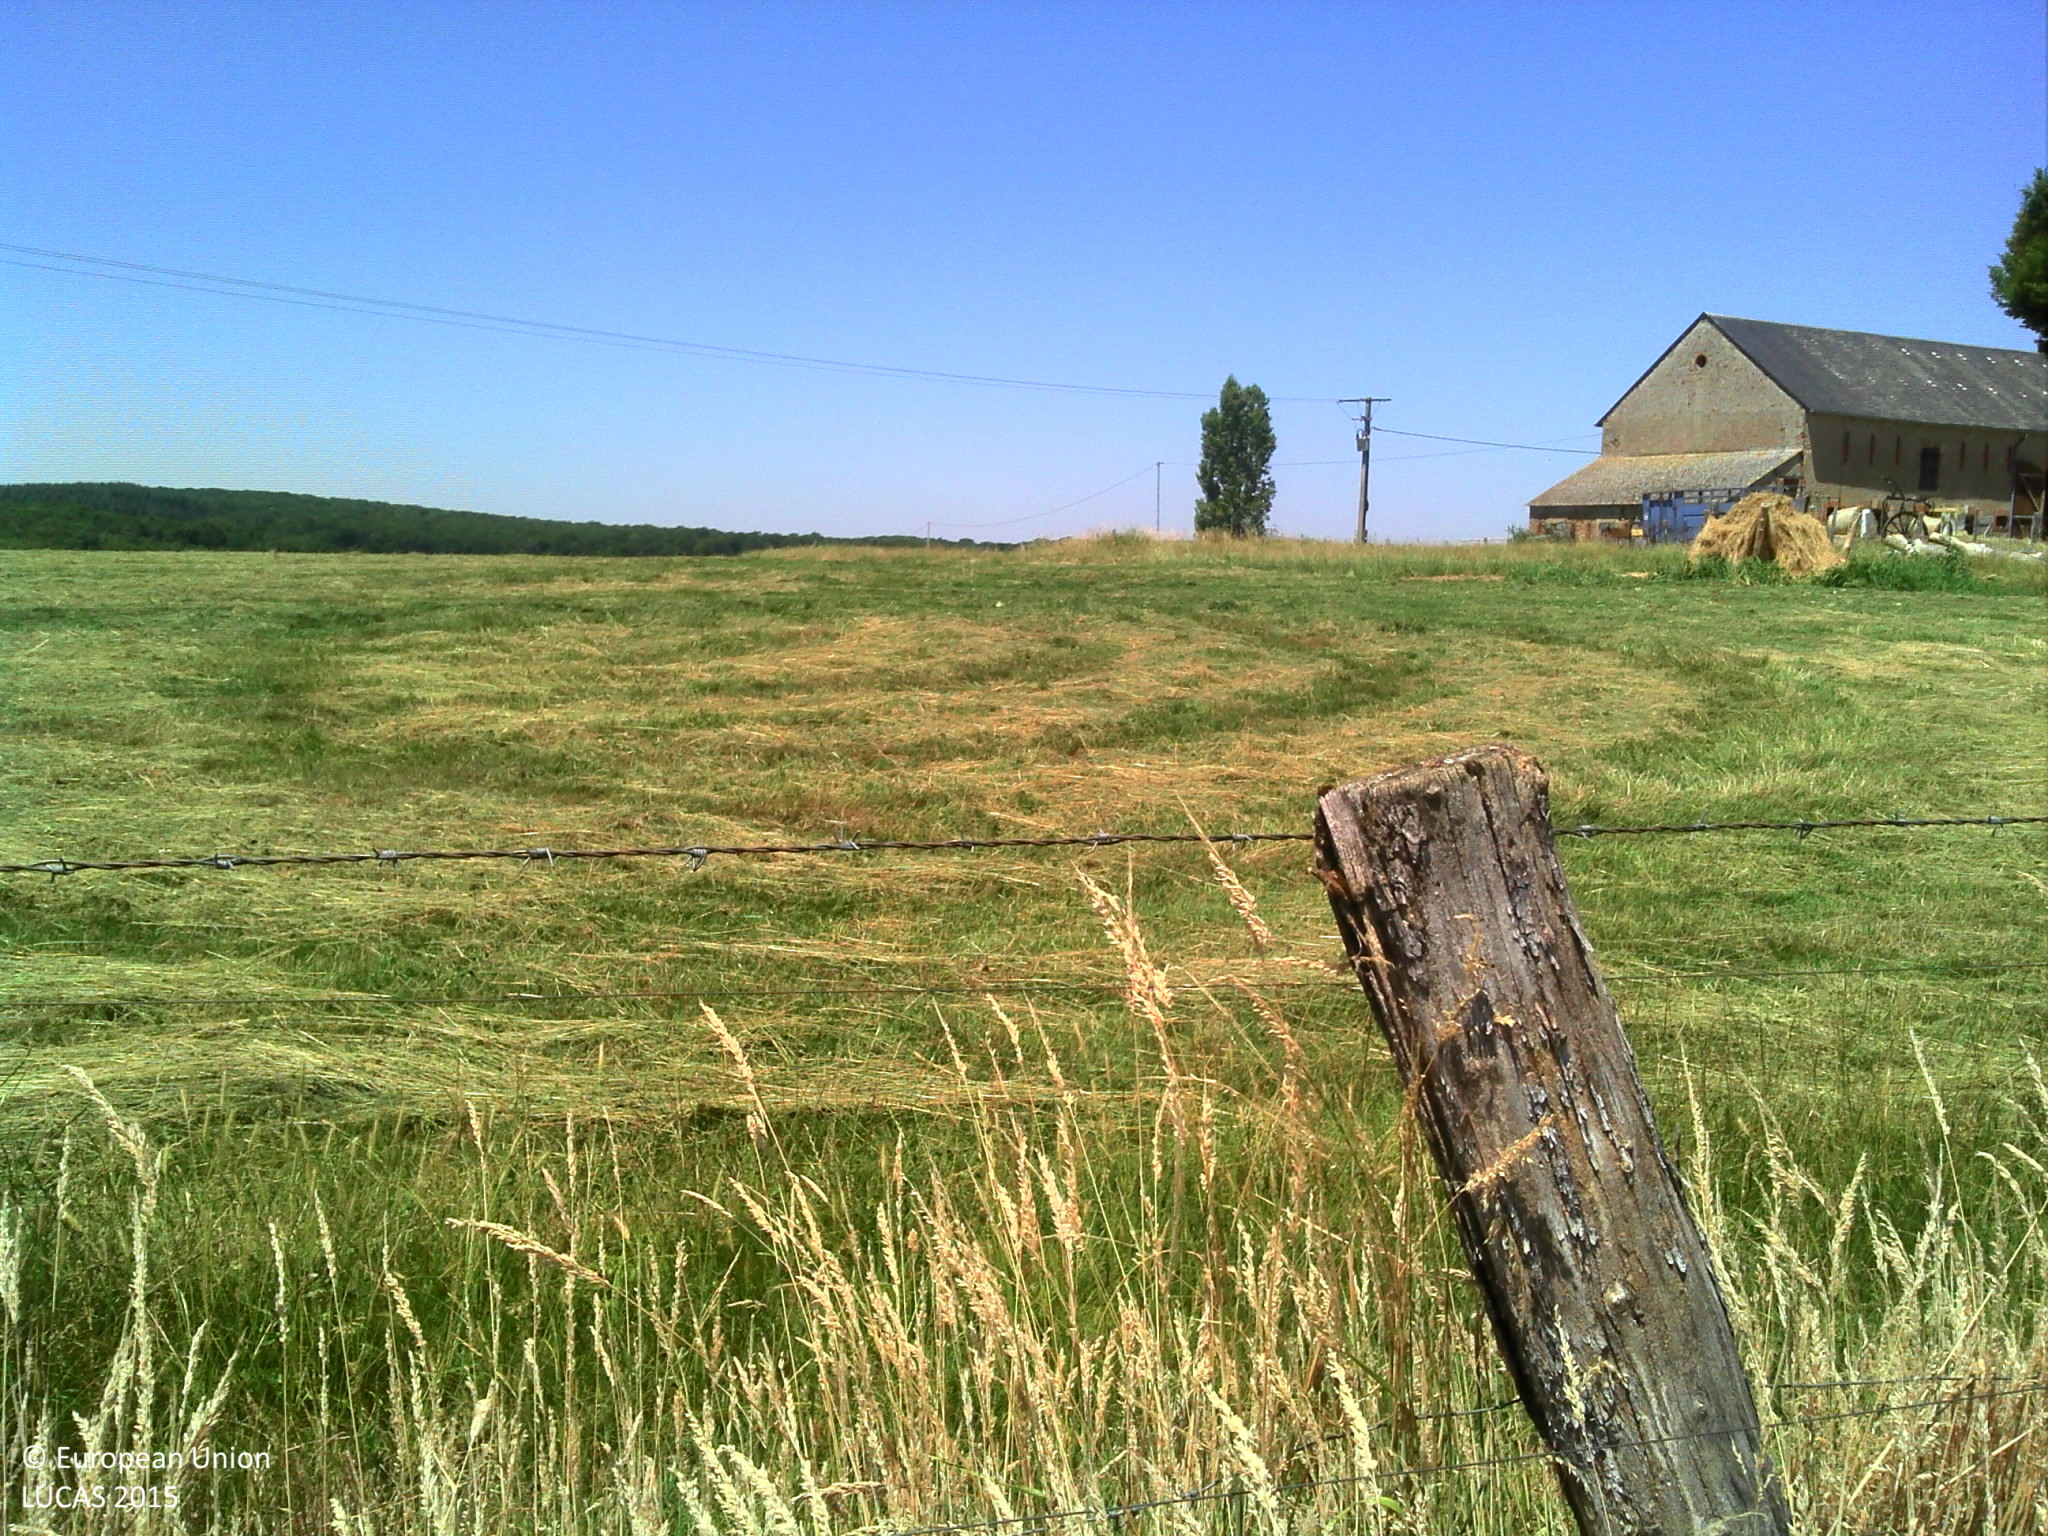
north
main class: Grassland
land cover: Grassland without tree/shrub cover
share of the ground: > 75 %
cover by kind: herbaceous plants 100 %
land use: Agriculture (excluding fallow land and kitchen gardens)
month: June
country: FR
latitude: 46.9363
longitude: 3.6010
